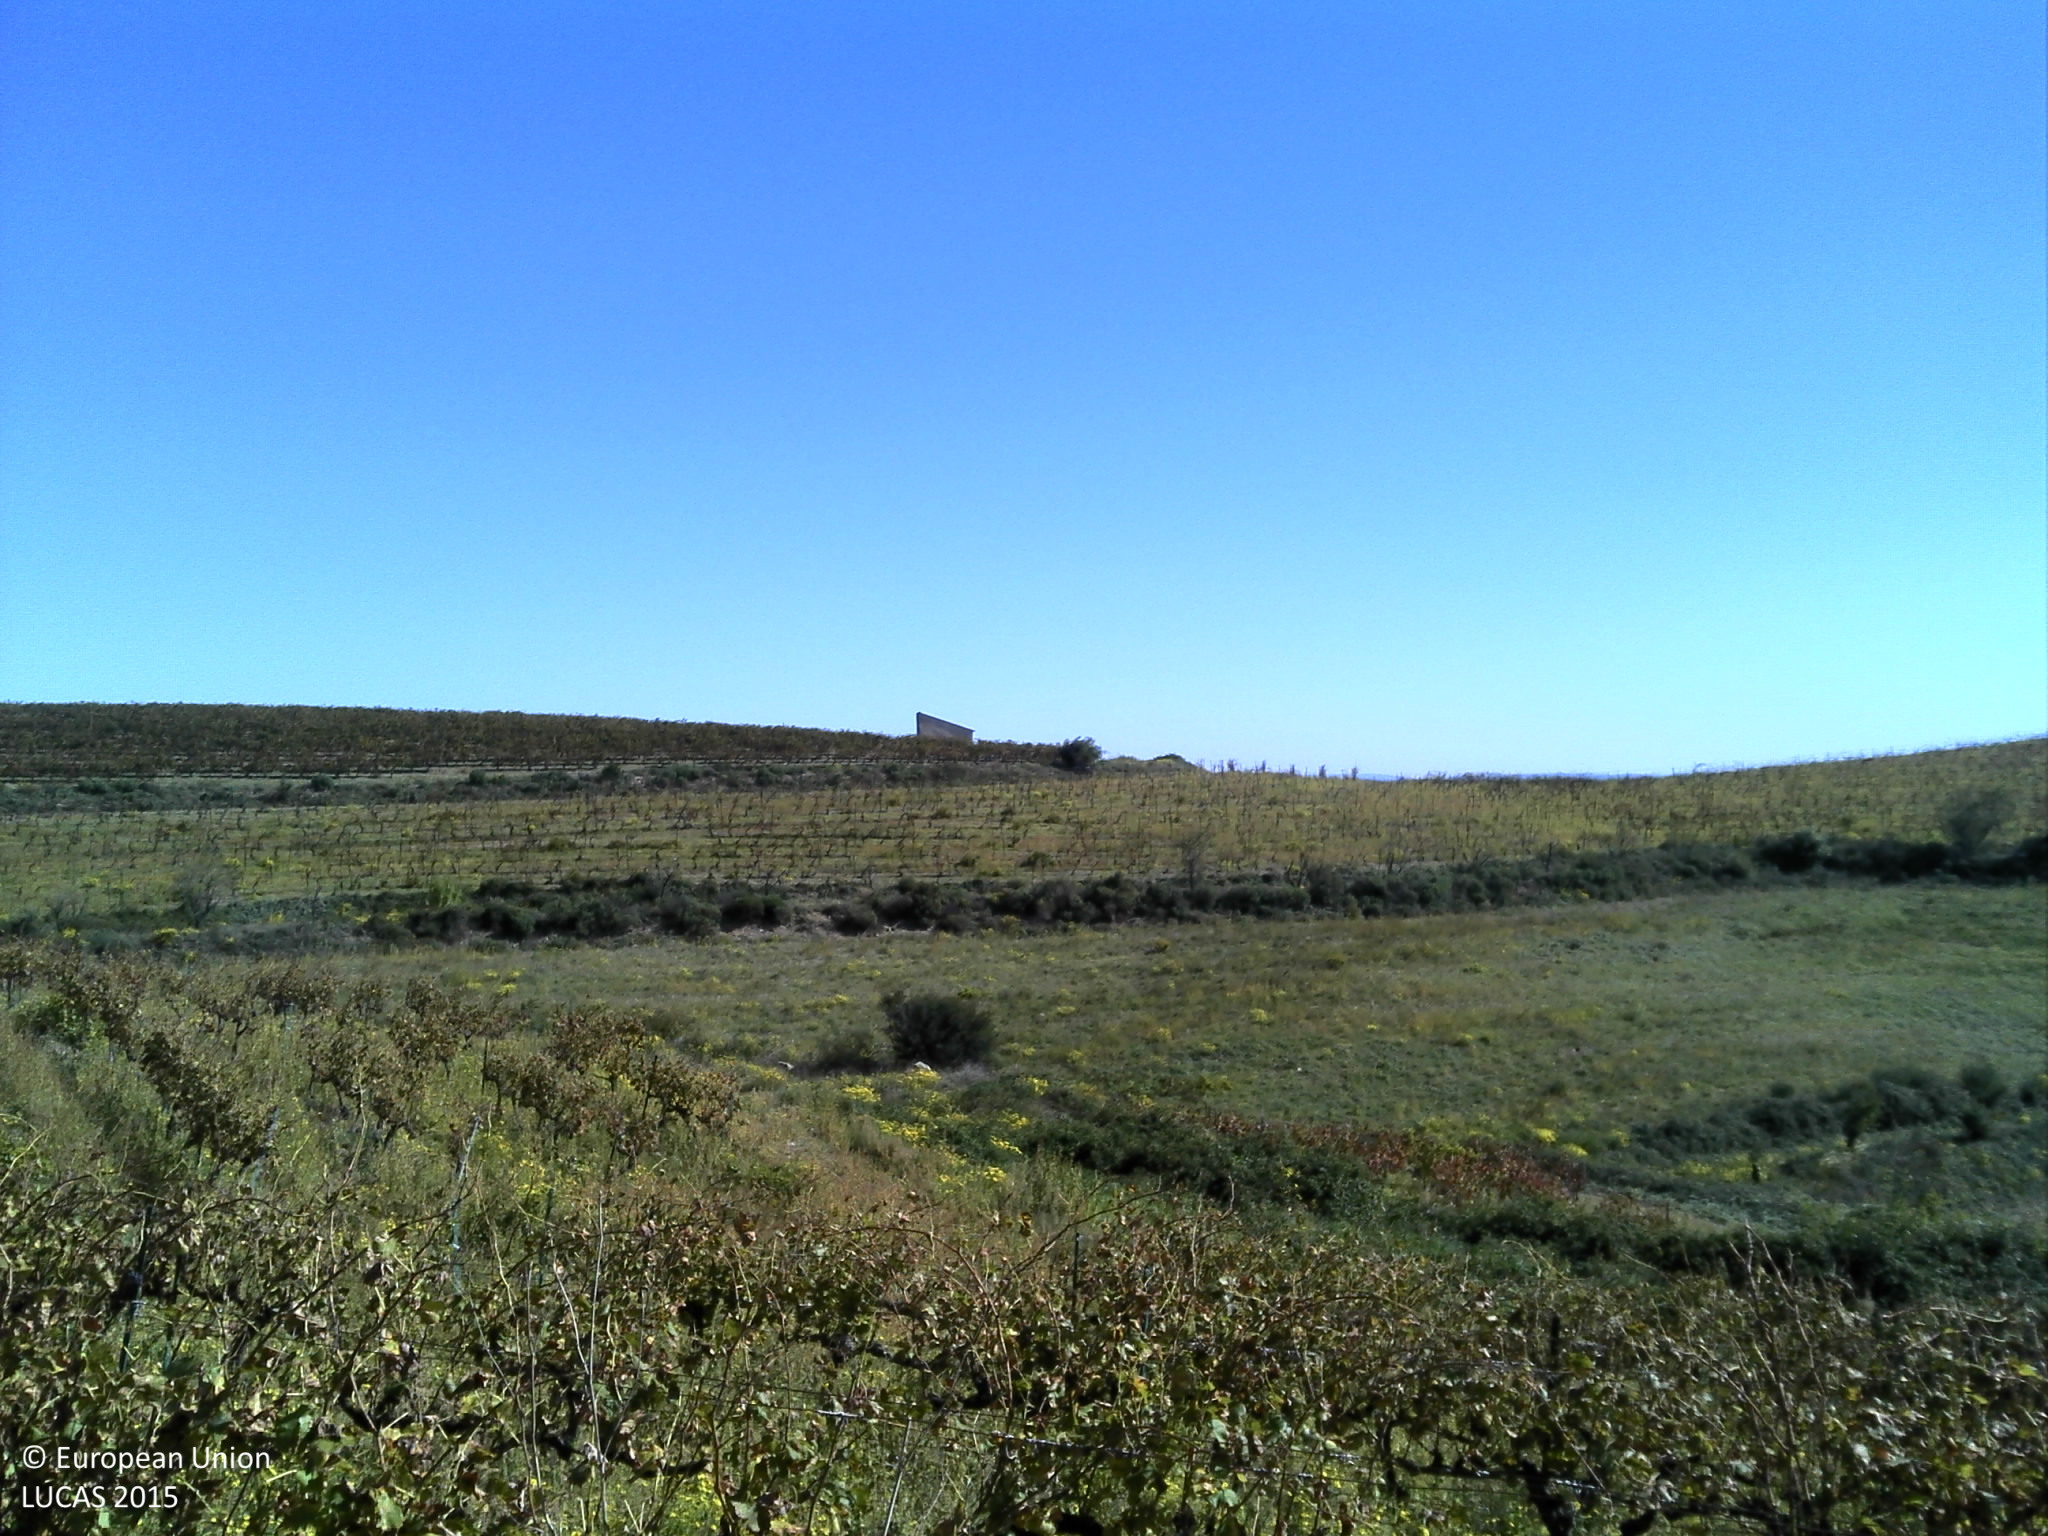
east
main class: Cropland
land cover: Vineyards
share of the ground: 10 - 25 %
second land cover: Spontaneously vegetated surfaces
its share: 50 - 75 %
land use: Agriculture (excluding fallow land and kitchen gardens)
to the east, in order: Vineyards; Spontaneously vegetated surfaces; Abandoned hedges; Vineyards; Abandoned hedges; Grassland without tree/shrub cover; Abandoned hedges; Spontaneously vegetated surfaces; Vineyards; Tracks; Vineyards
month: October
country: FR
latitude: 43.5442
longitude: 3.1394
